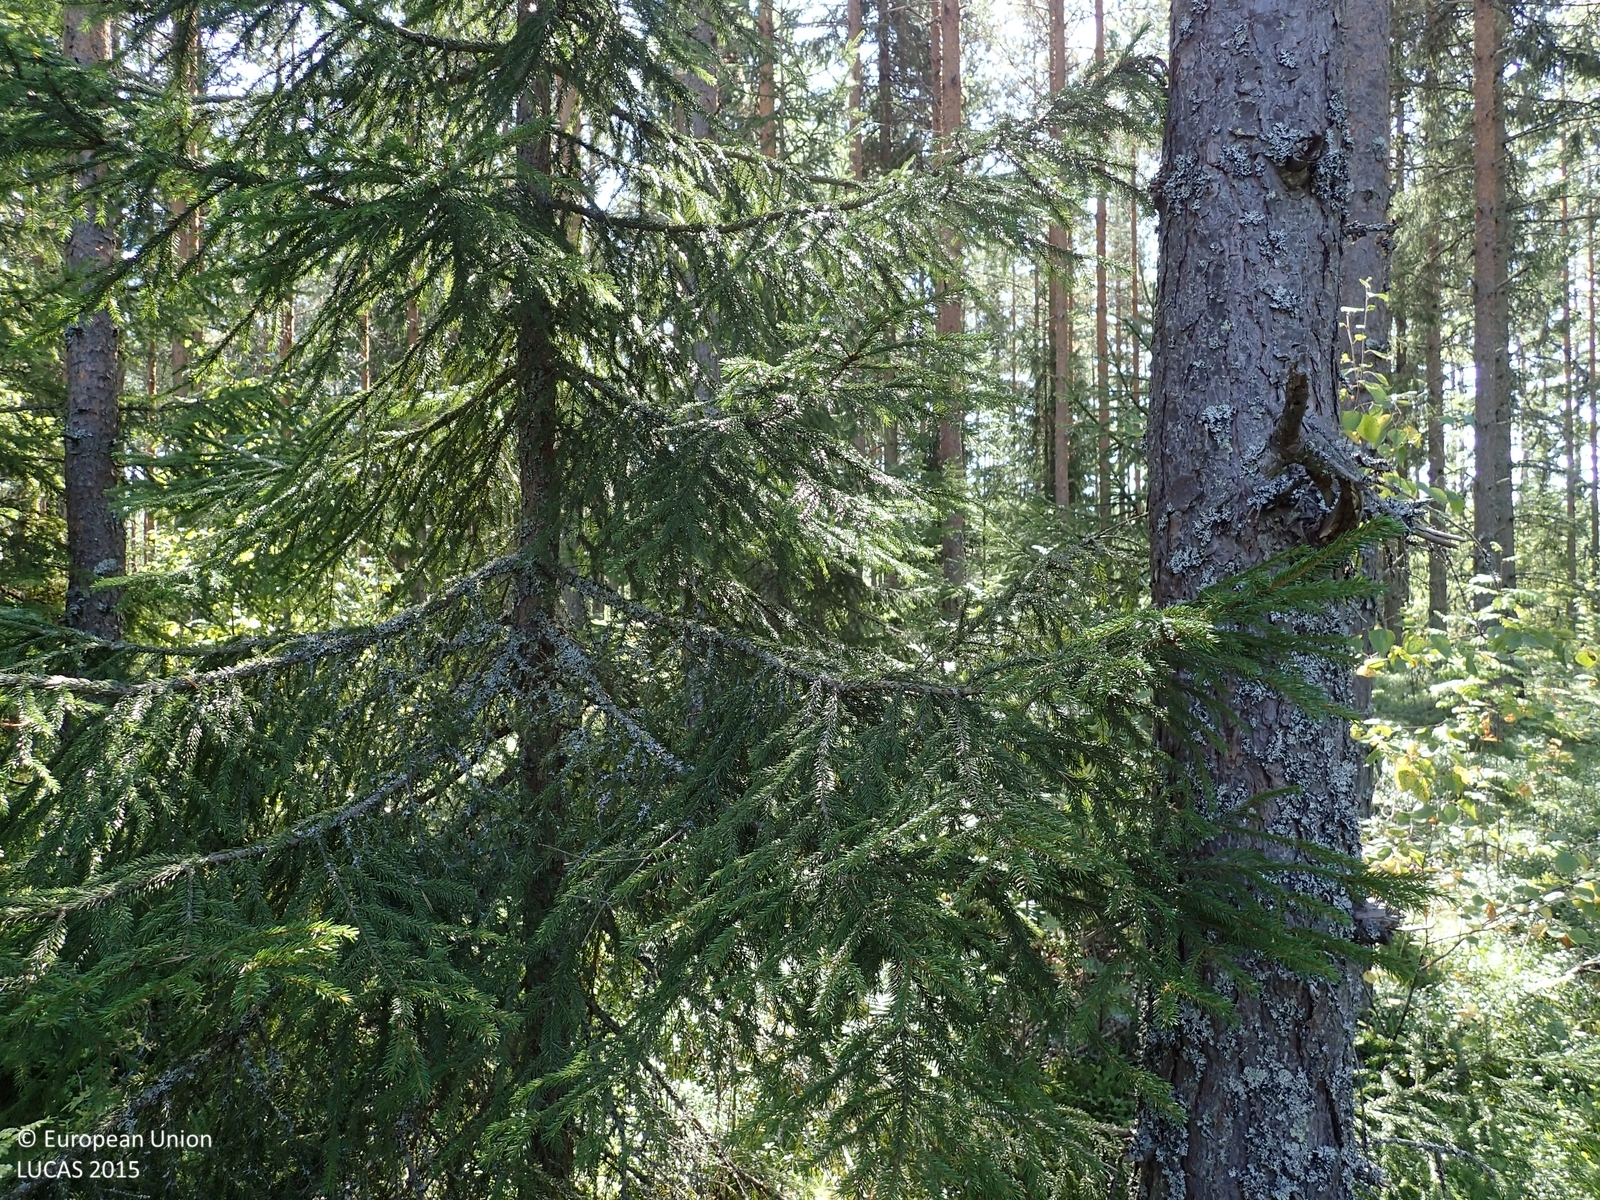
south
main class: Woodland
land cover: Pine dominated coniferous woodland
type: boreal forest
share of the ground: > 75 %
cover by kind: coniferous forest trees 70 %, shrubs 20 %, broadleaved forest trees 5 %, herbaceous plants 5 %
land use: Forestry
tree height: > 5 m
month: August
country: FI
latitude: 62.5863
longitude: 21.7856
